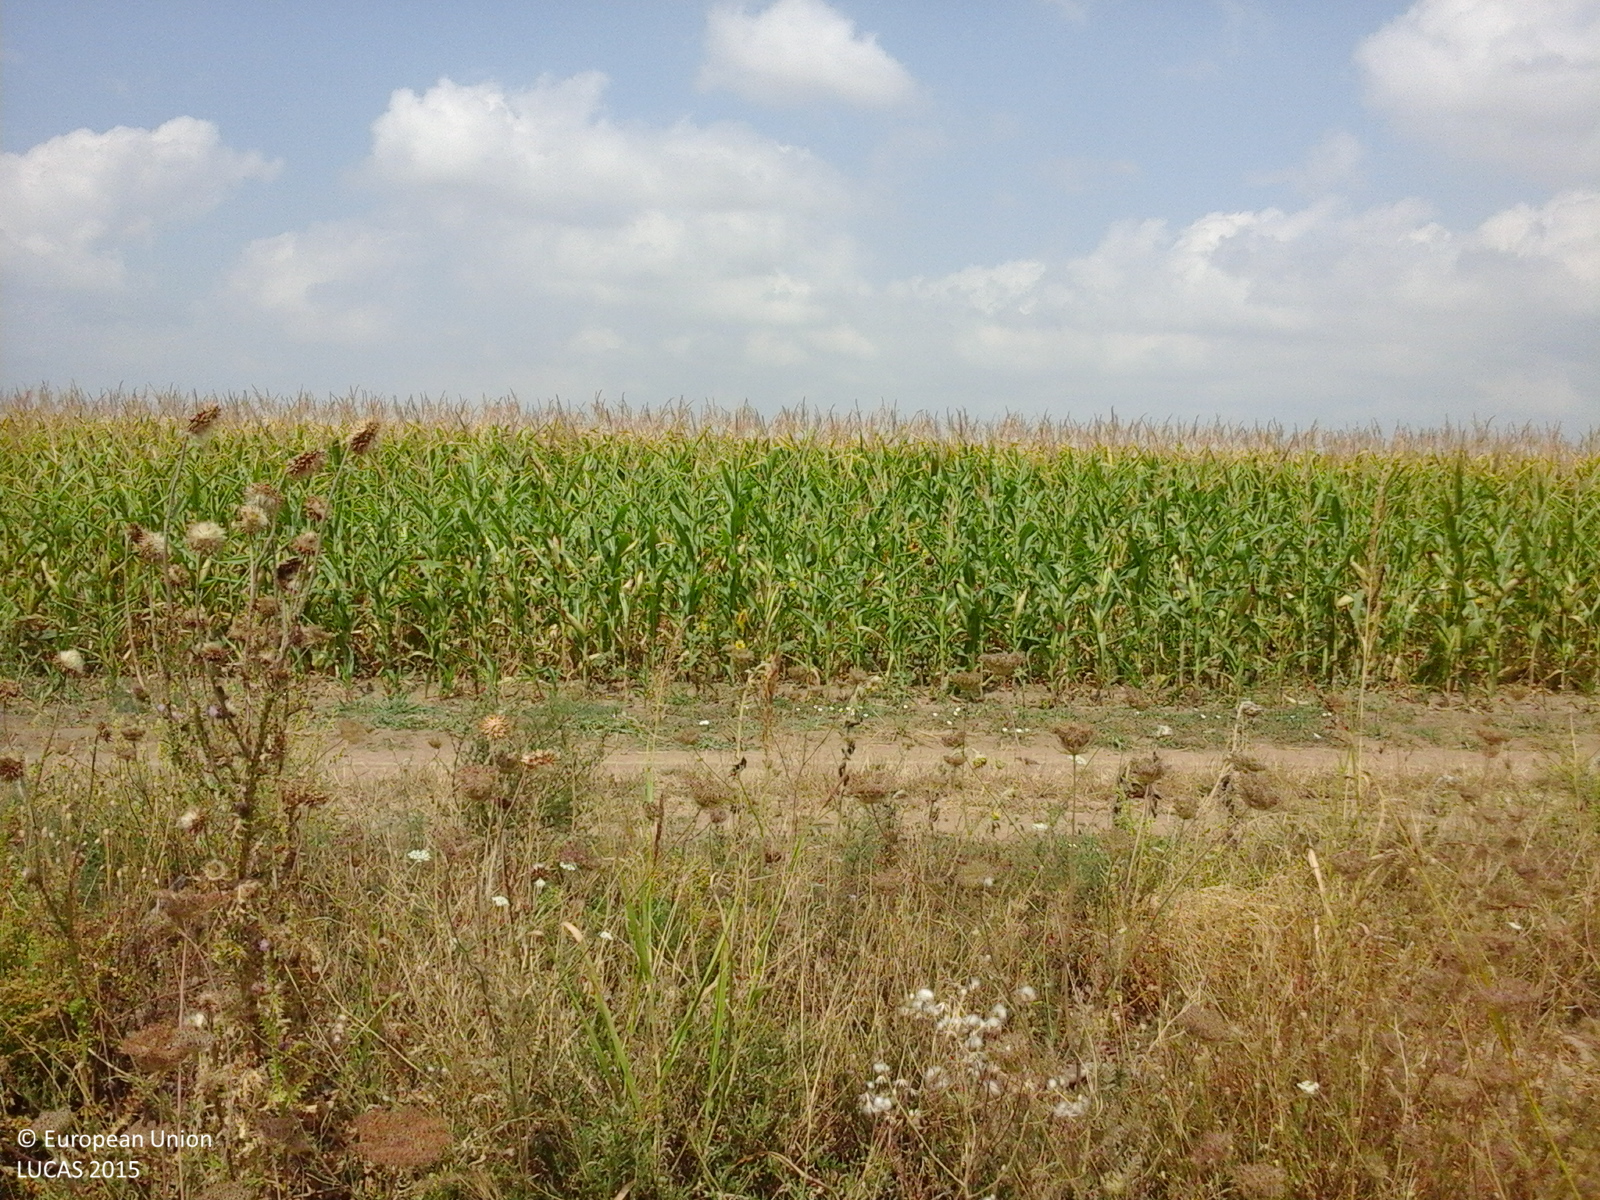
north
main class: Cropland
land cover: Sunflower
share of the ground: > 75 %
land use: Agriculture (excluding fallow land and kitchen gardens)
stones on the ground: < 10 %
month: July
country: RO
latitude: 44.9861
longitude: 28.2441
